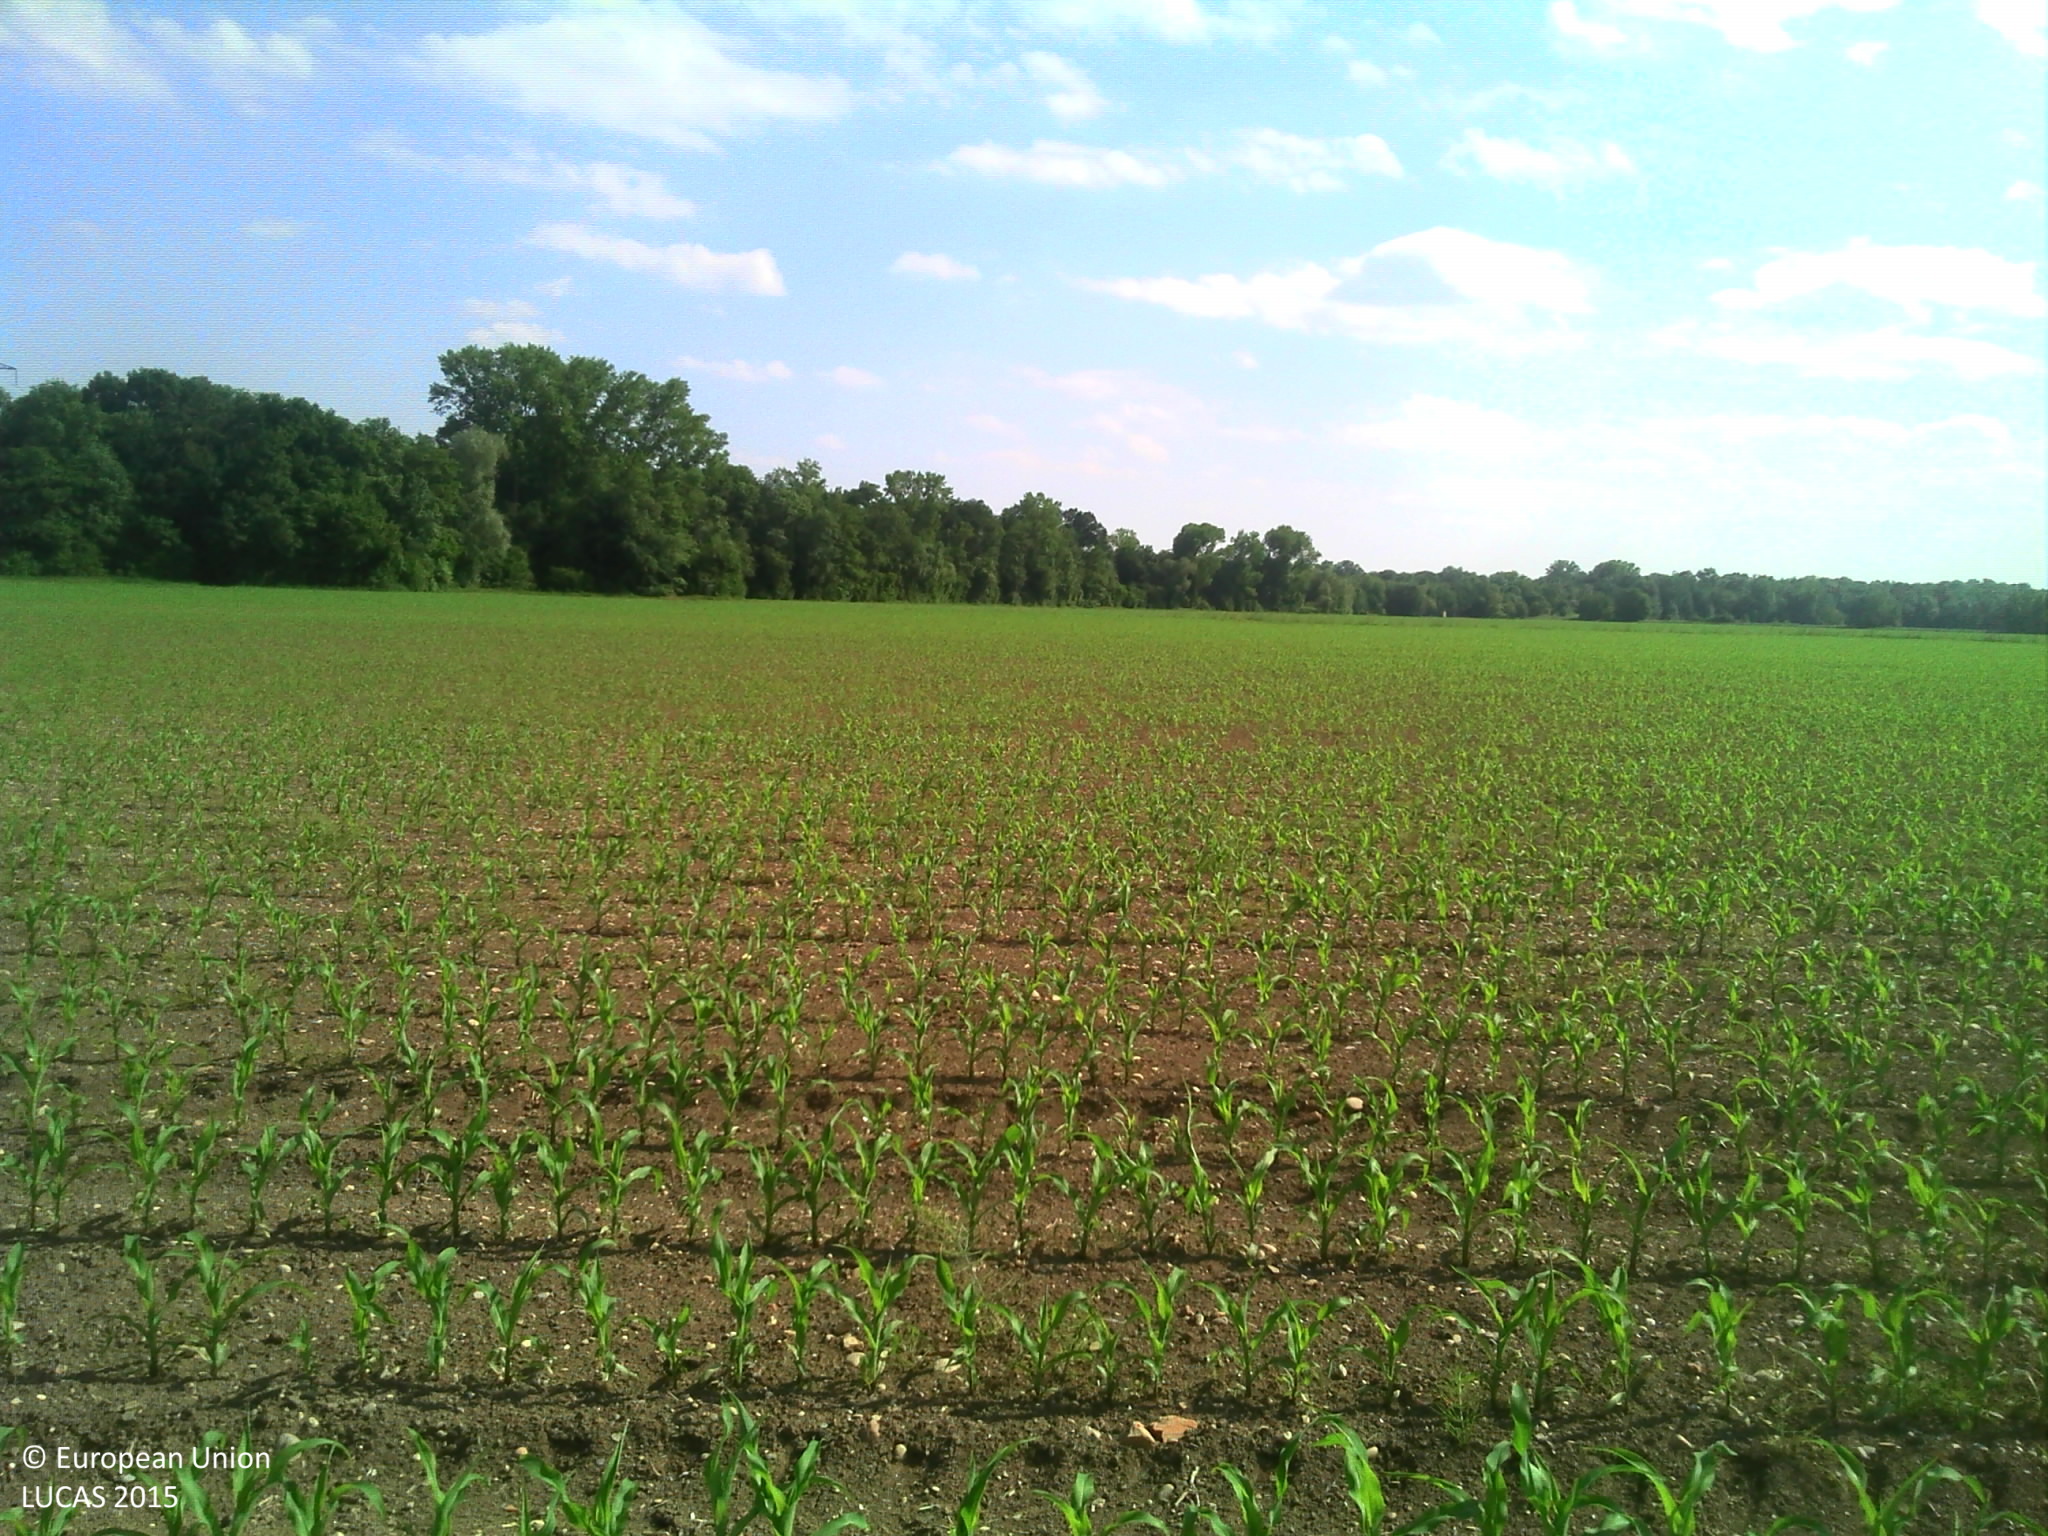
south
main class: Cropland
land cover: Maize
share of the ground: 10 - 25 %
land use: Agriculture (excluding fallow land and kitchen gardens)
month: May
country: FR
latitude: 48.3040
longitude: 7.5338
